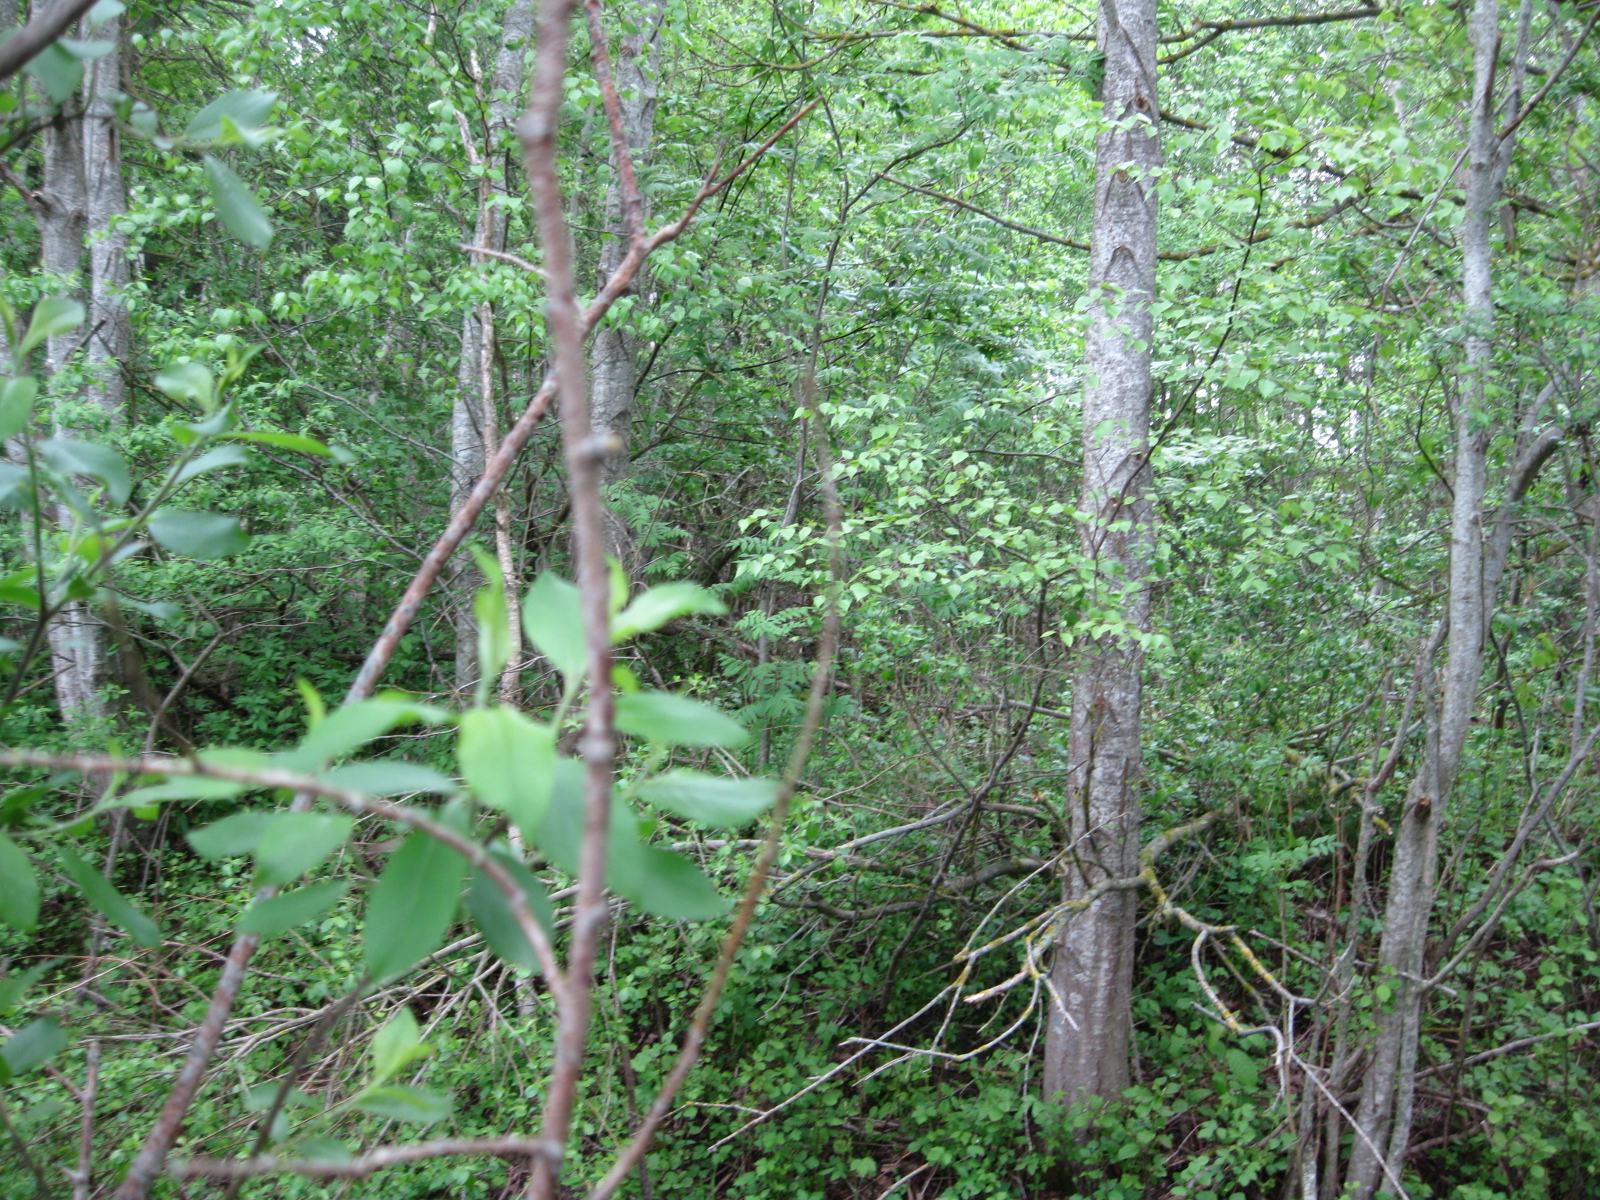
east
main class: Woodland
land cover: Broadleaved woodland
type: non-riverine alder, birch or aspen forest
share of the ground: > 75 %
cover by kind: broadleaved forest trees 85 %, shrubs 5 %, herbaceous plants 5 %, unconsolidated bare surface 5 %
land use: Forestry
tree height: > 5 m
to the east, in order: Broadleaved woodland
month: May
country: LT
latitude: 56.2012
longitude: 23.8322
